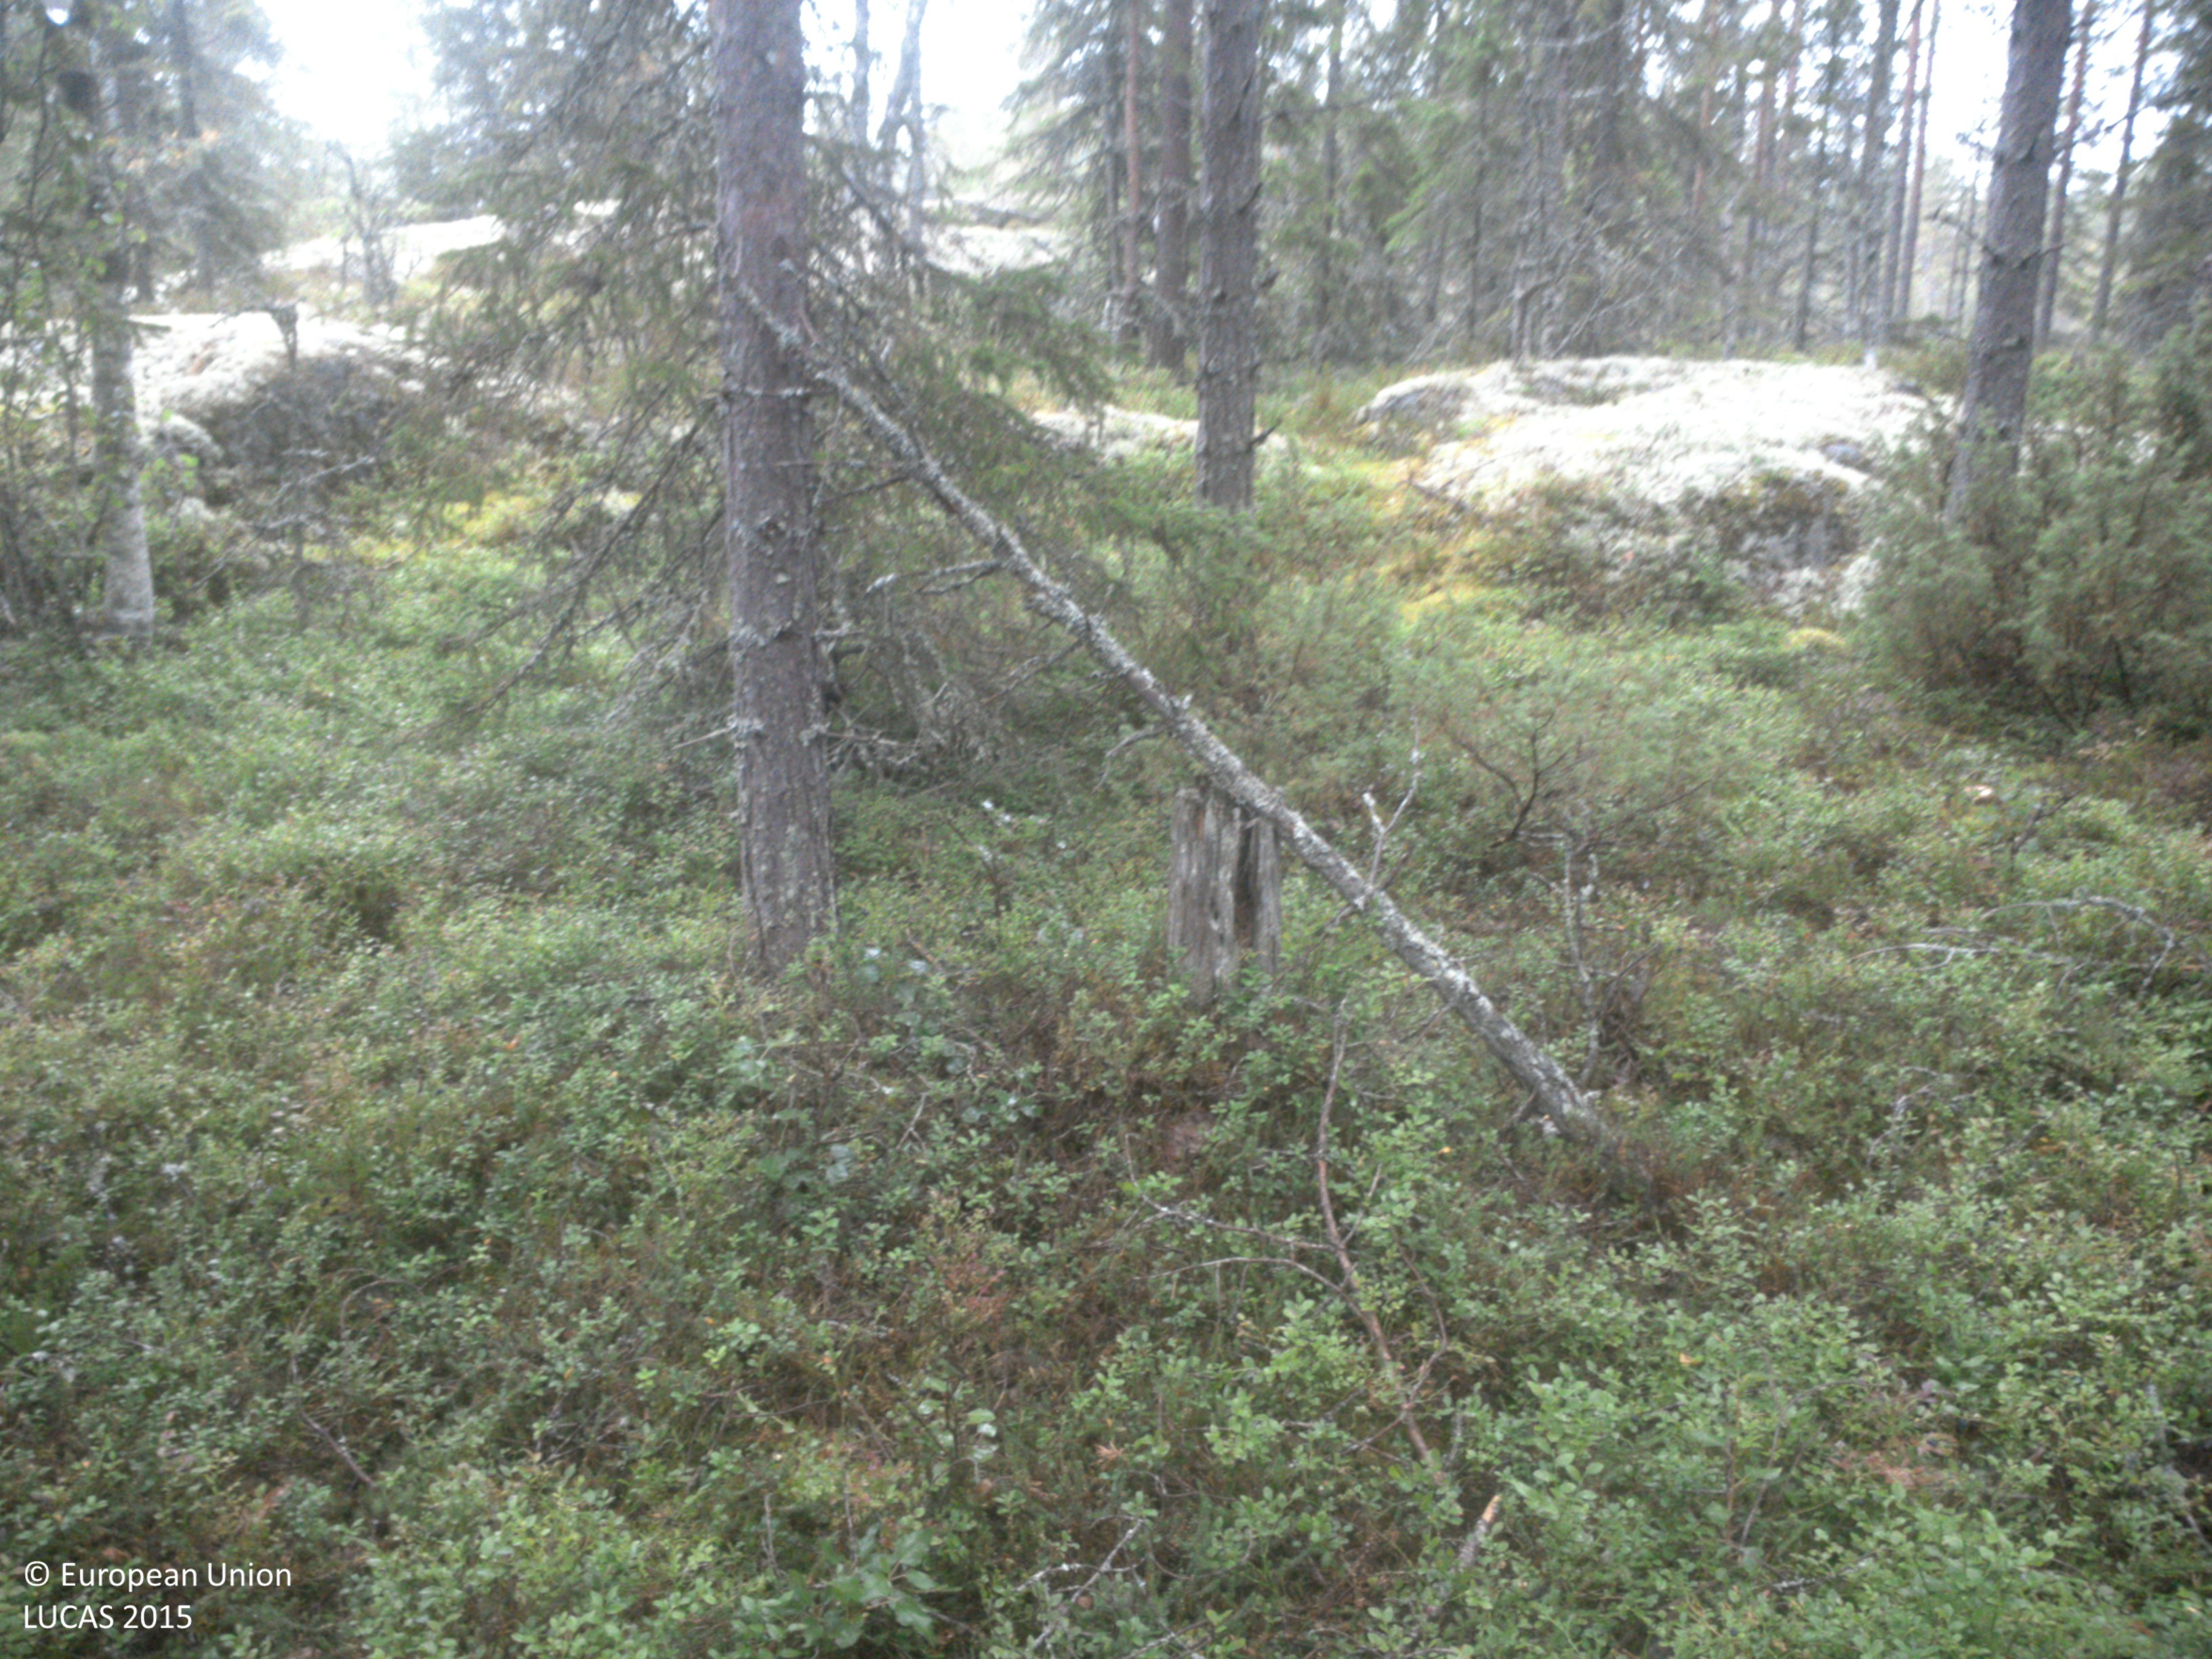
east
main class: Woodland
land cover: Other coniferous woodland
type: boreal forest
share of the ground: 50 - 75 %
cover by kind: coniferous forest trees 50 %, shrubs 50 %
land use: Forestry
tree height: > 5 m
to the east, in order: Other coniferous woodland; Pine dominated mixed woodland; Pine dominated coniferous woodland; Lichens and moss; Pine dominated coniferous woodland
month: August
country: SE
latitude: 63.7021
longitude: 19.9547
